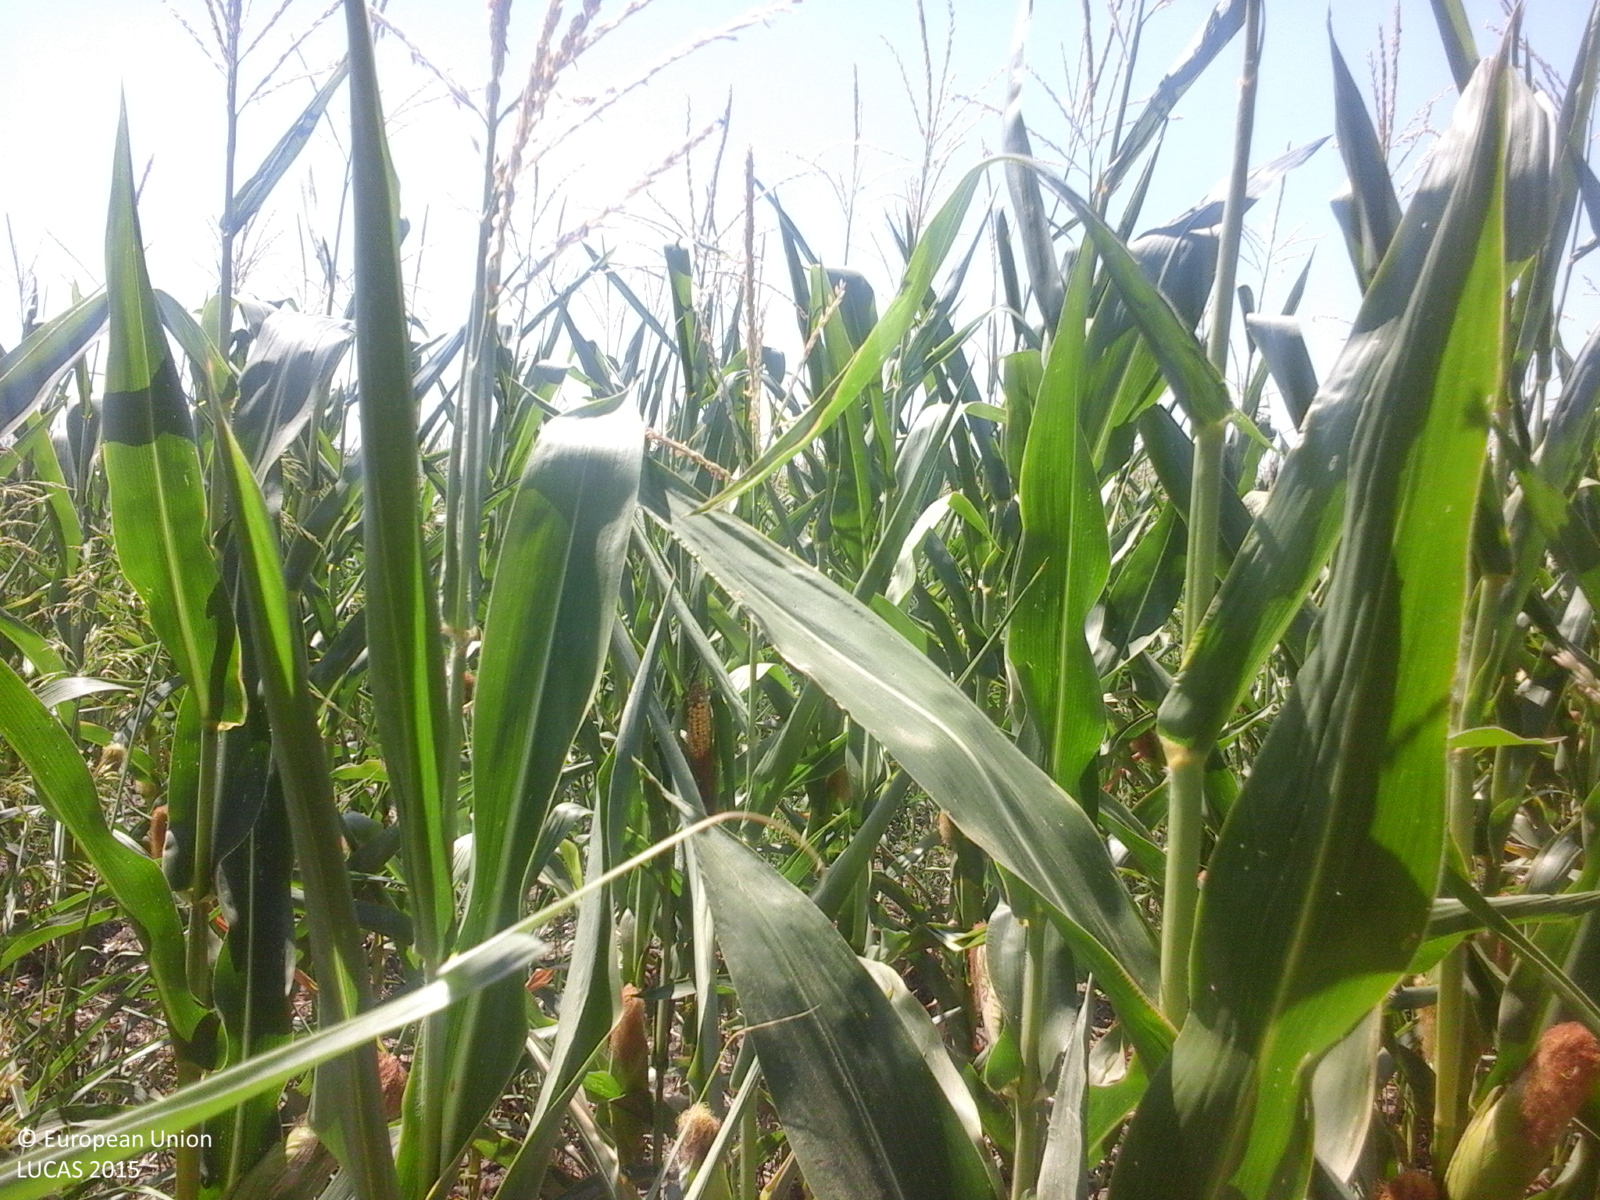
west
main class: Cropland
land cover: Maize
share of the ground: > 75 %
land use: Agriculture (excluding fallow land and kitchen gardens)
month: July
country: RO
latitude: 44.2252
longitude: 26.6534
